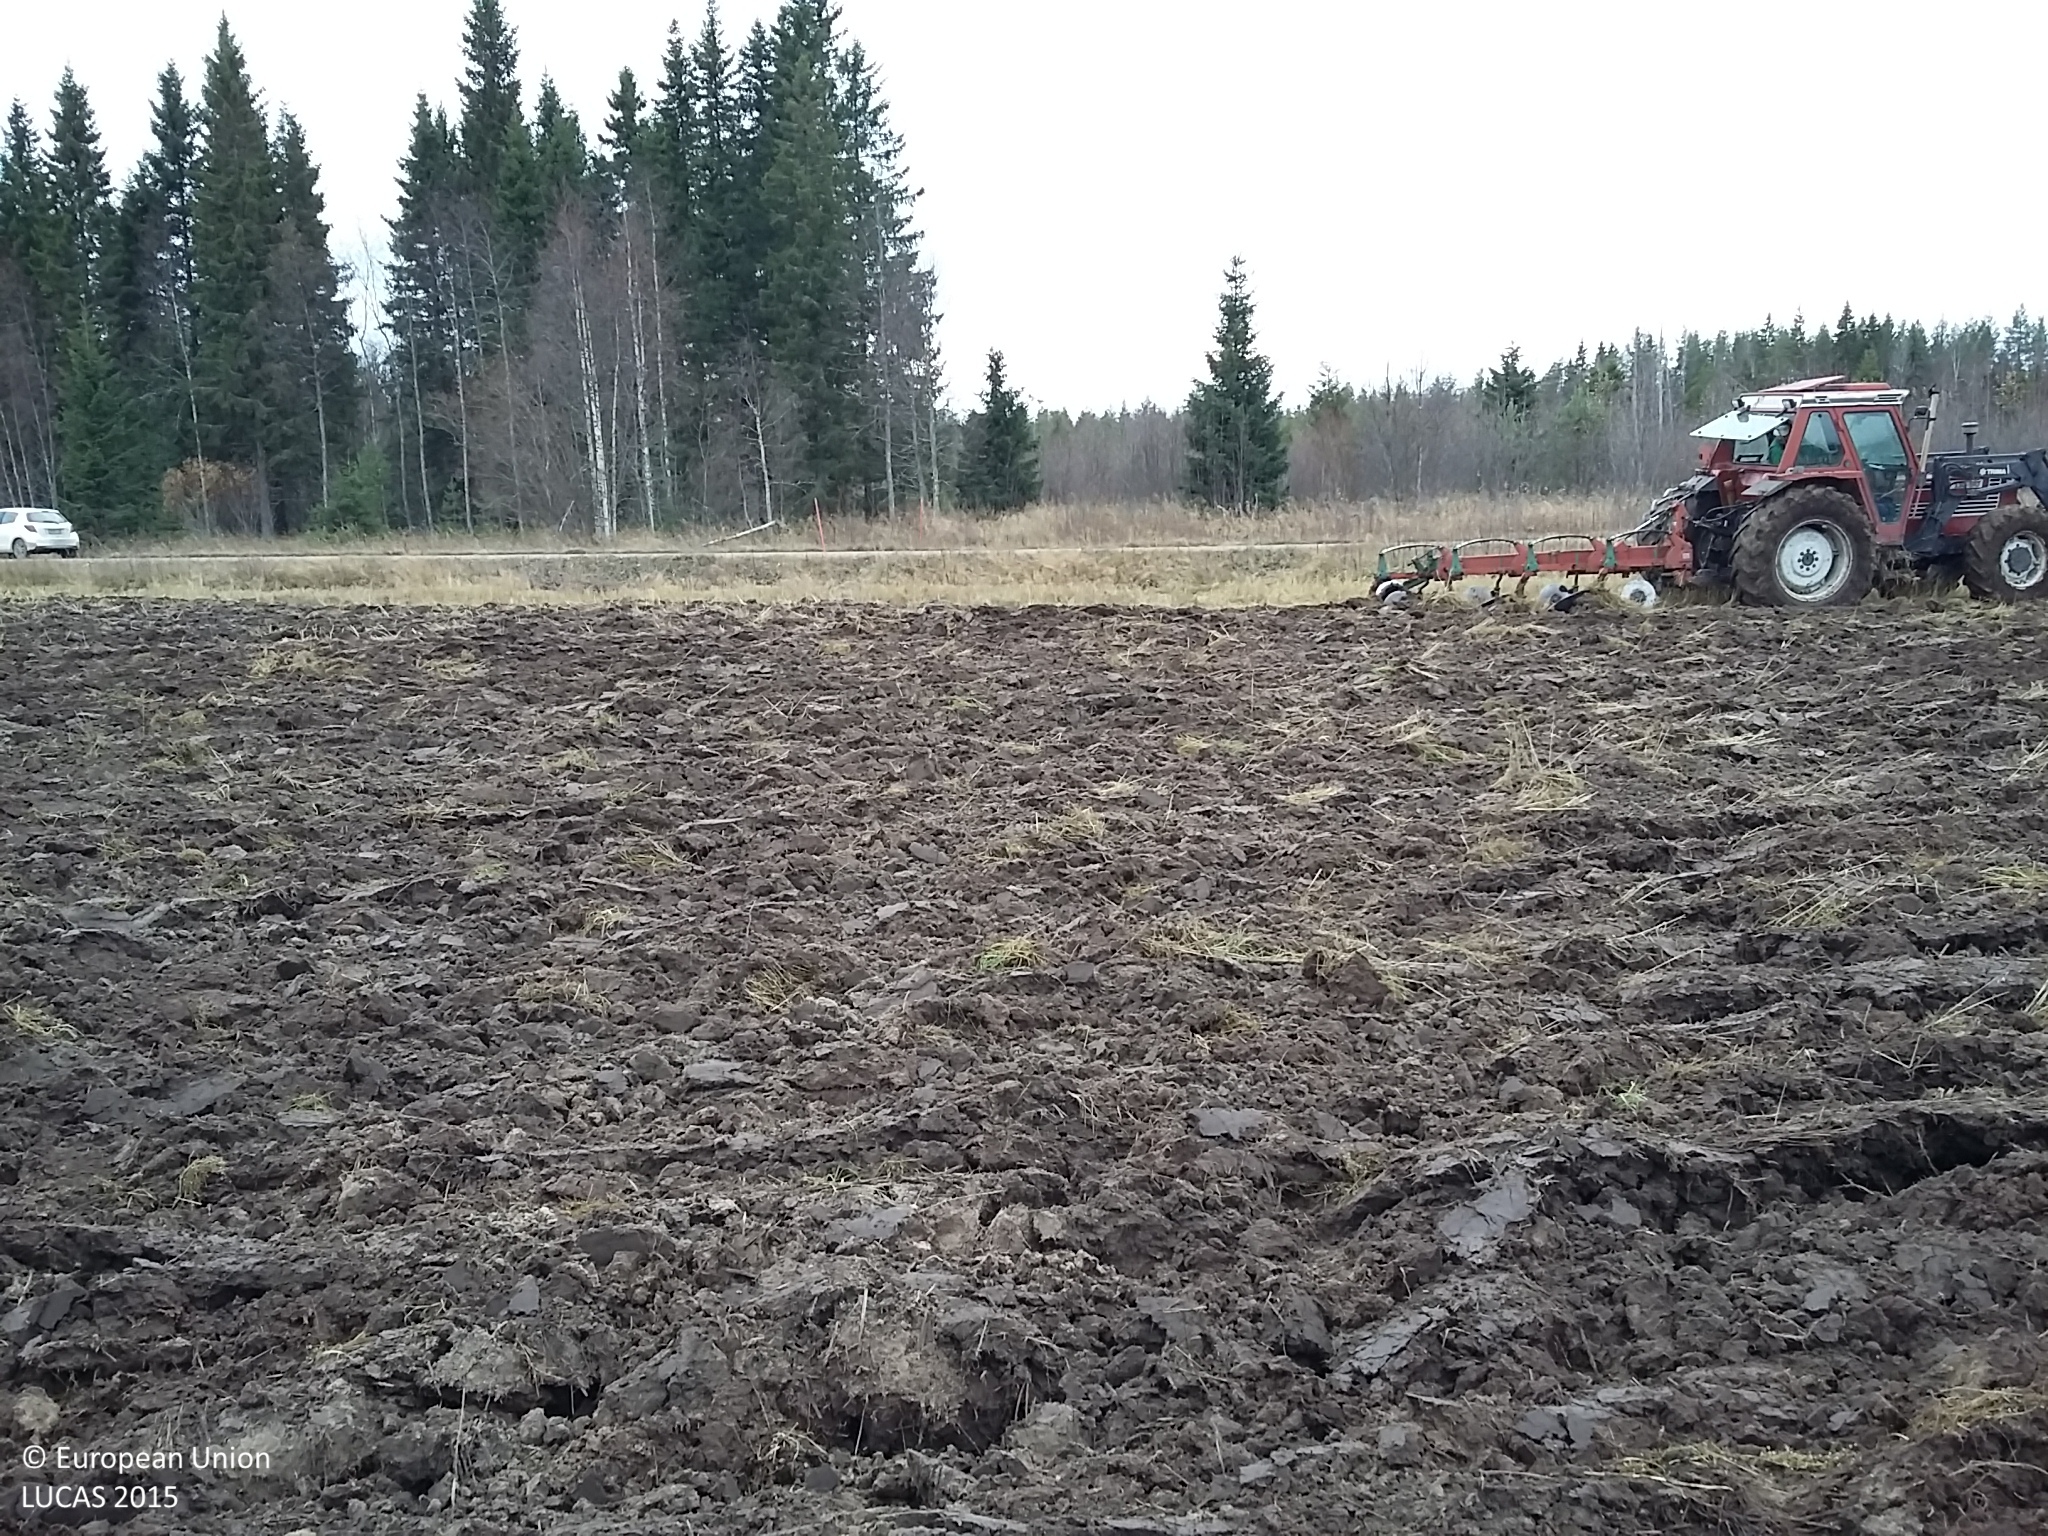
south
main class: Cropland
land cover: Oats
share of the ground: < 10 %
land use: Agriculture (excluding fallow land and kitchen gardens)
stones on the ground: < 10 %
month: October
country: FI
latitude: 64.6844
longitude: 25.4930
